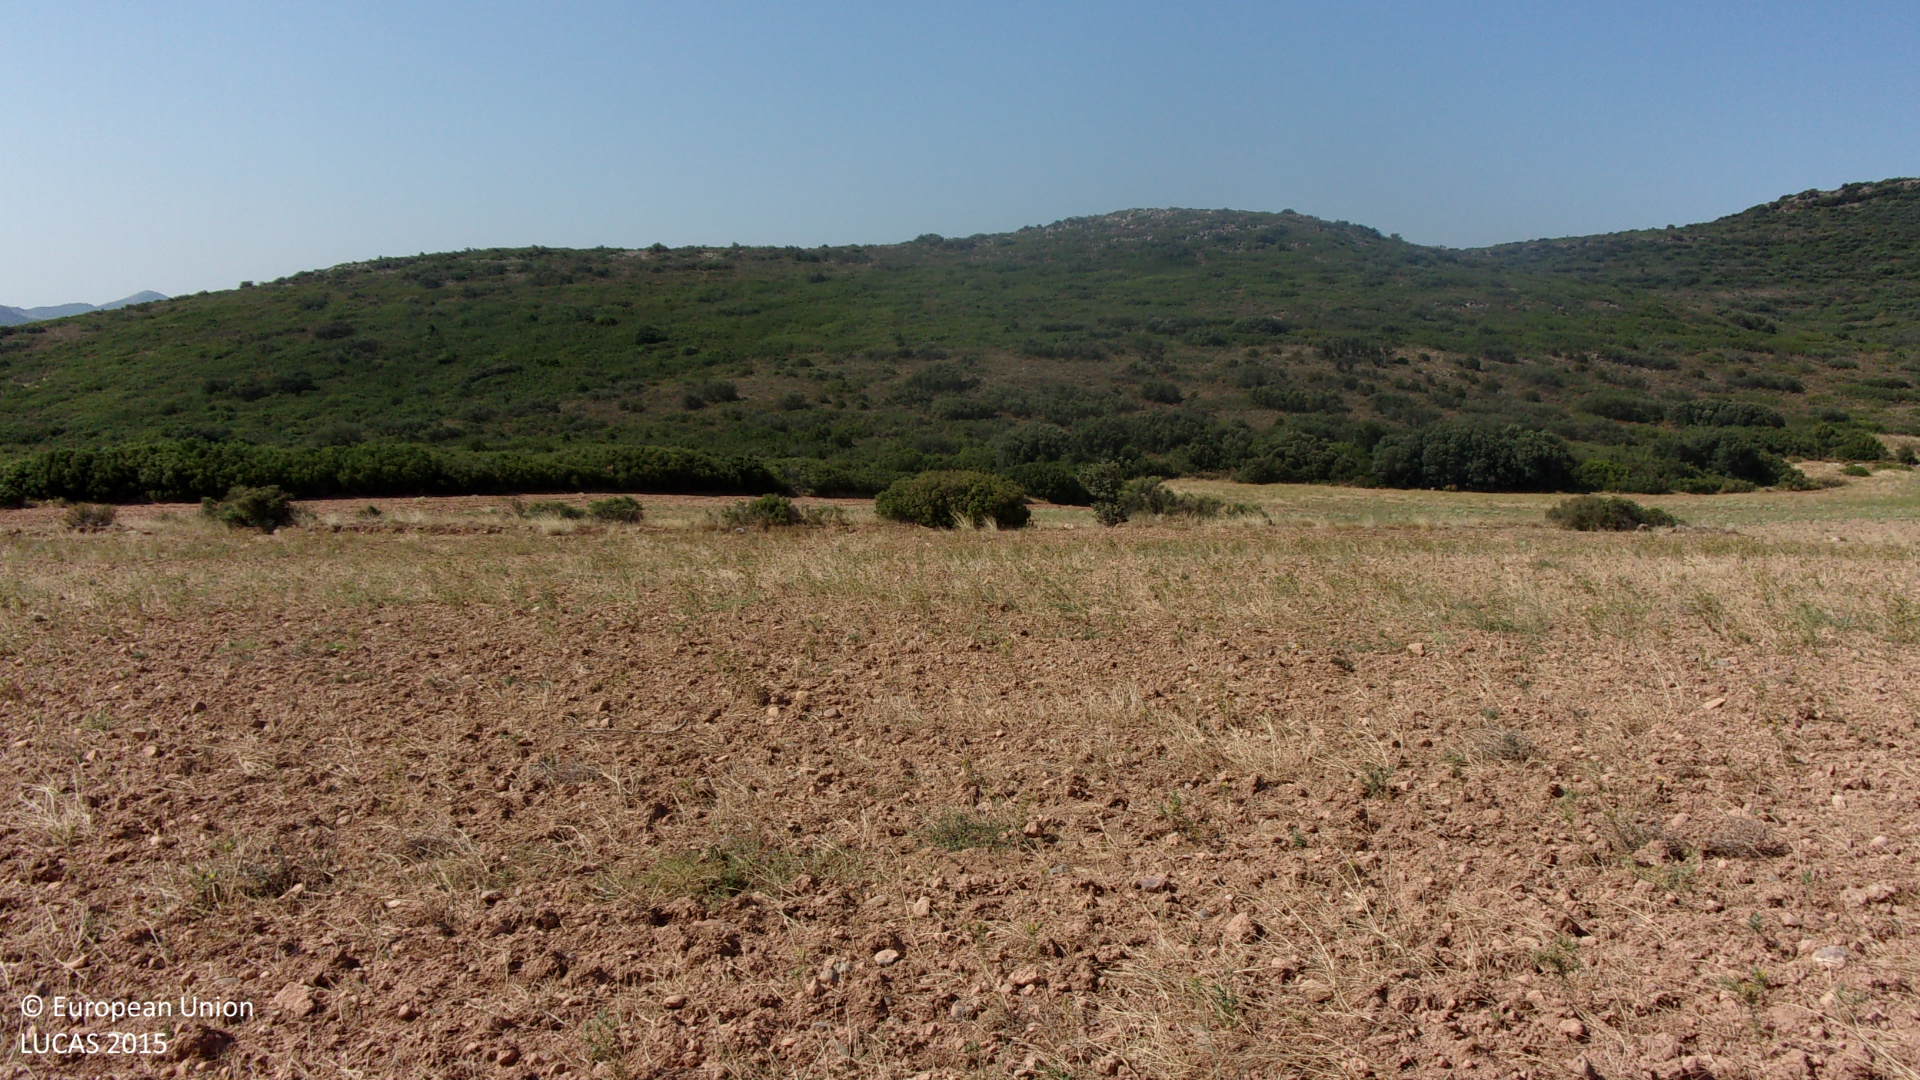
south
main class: Grassland
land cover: Spontaneously vegetated surfaces
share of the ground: 25 - 50 %
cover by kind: unconsolidated bare surface 65 %, herbaceous plants 35 %
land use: Fallow land
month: July
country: ES
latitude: 41.6744
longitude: -1.4499
